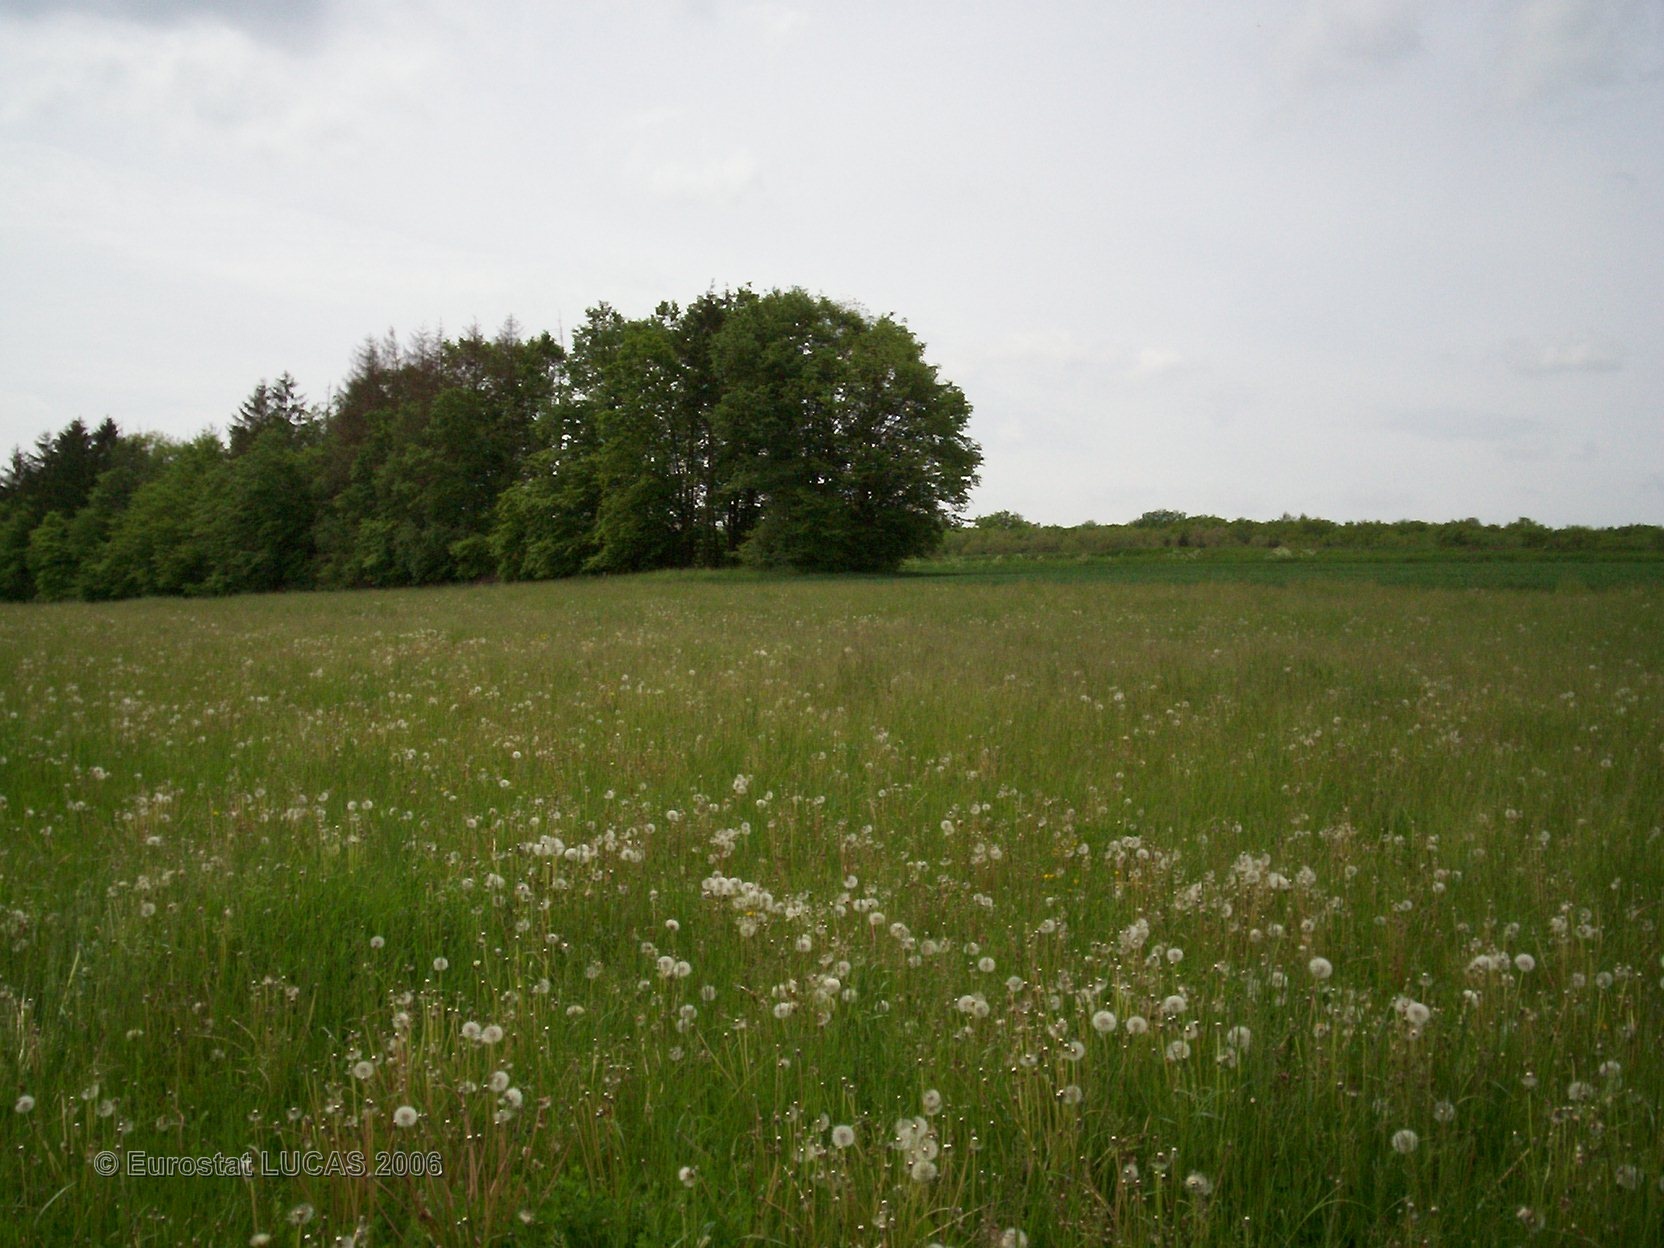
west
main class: Grassland
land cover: Grassland without tree/shrub cover
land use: Agriculture (excluding fallow land and kitchen gardens)
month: May
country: FR
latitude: 48.4398
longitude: 6.5535
